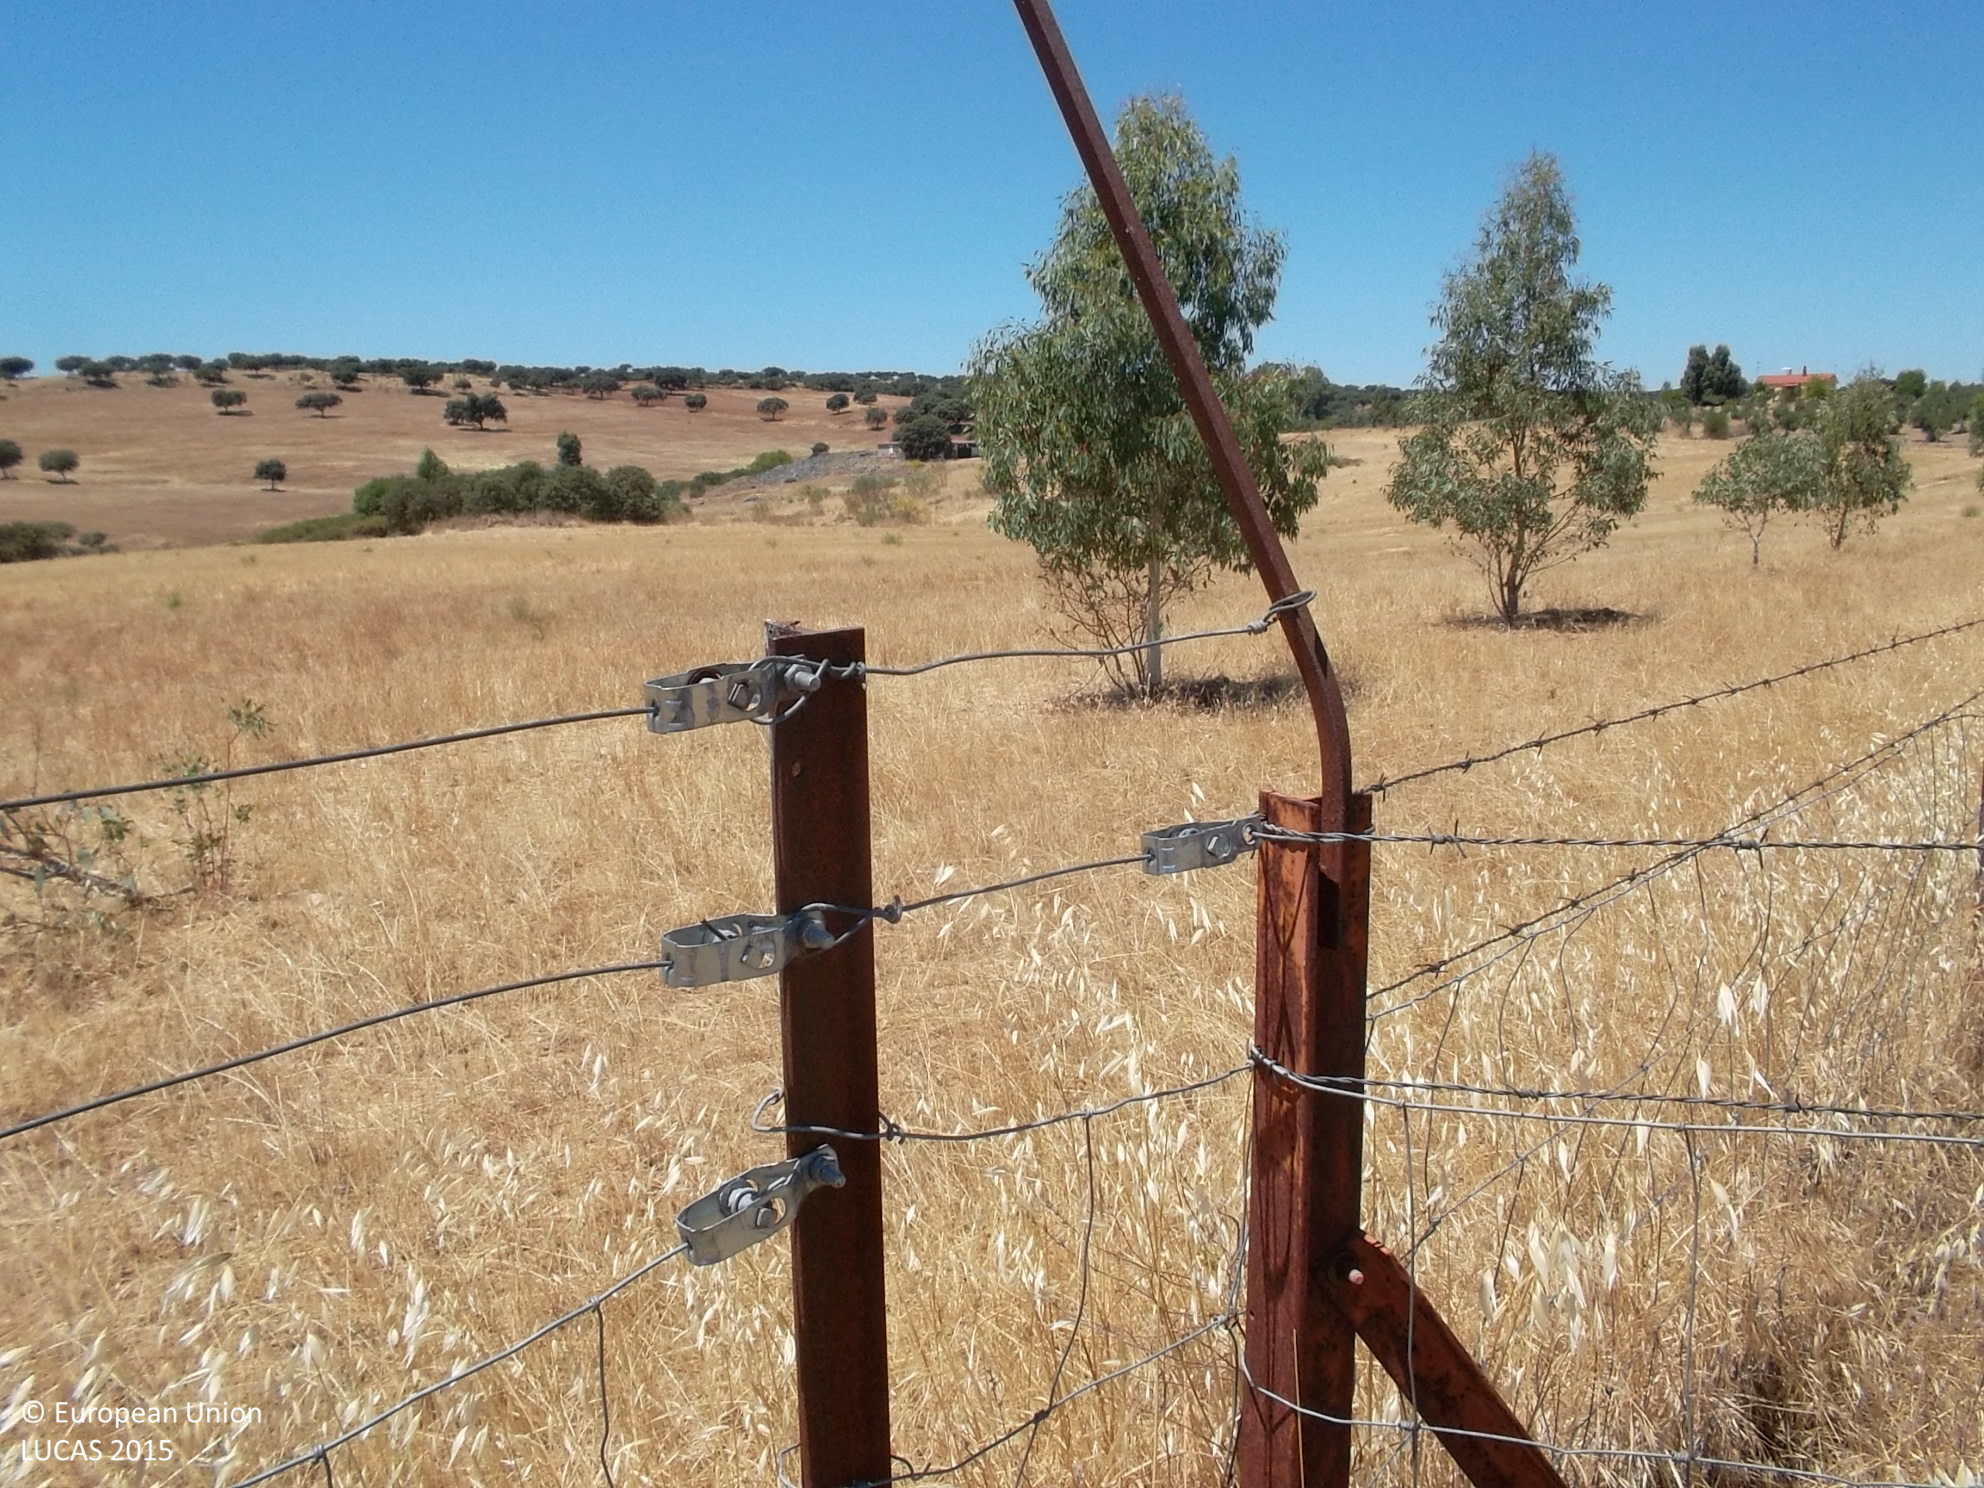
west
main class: Cropland
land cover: Mixed cereals for fodder
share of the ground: < 10 %
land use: Agriculture (excluding fallow land and kitchen gardens)
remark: Harvested field
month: July
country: ES
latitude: 38.2225
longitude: -5.6943
